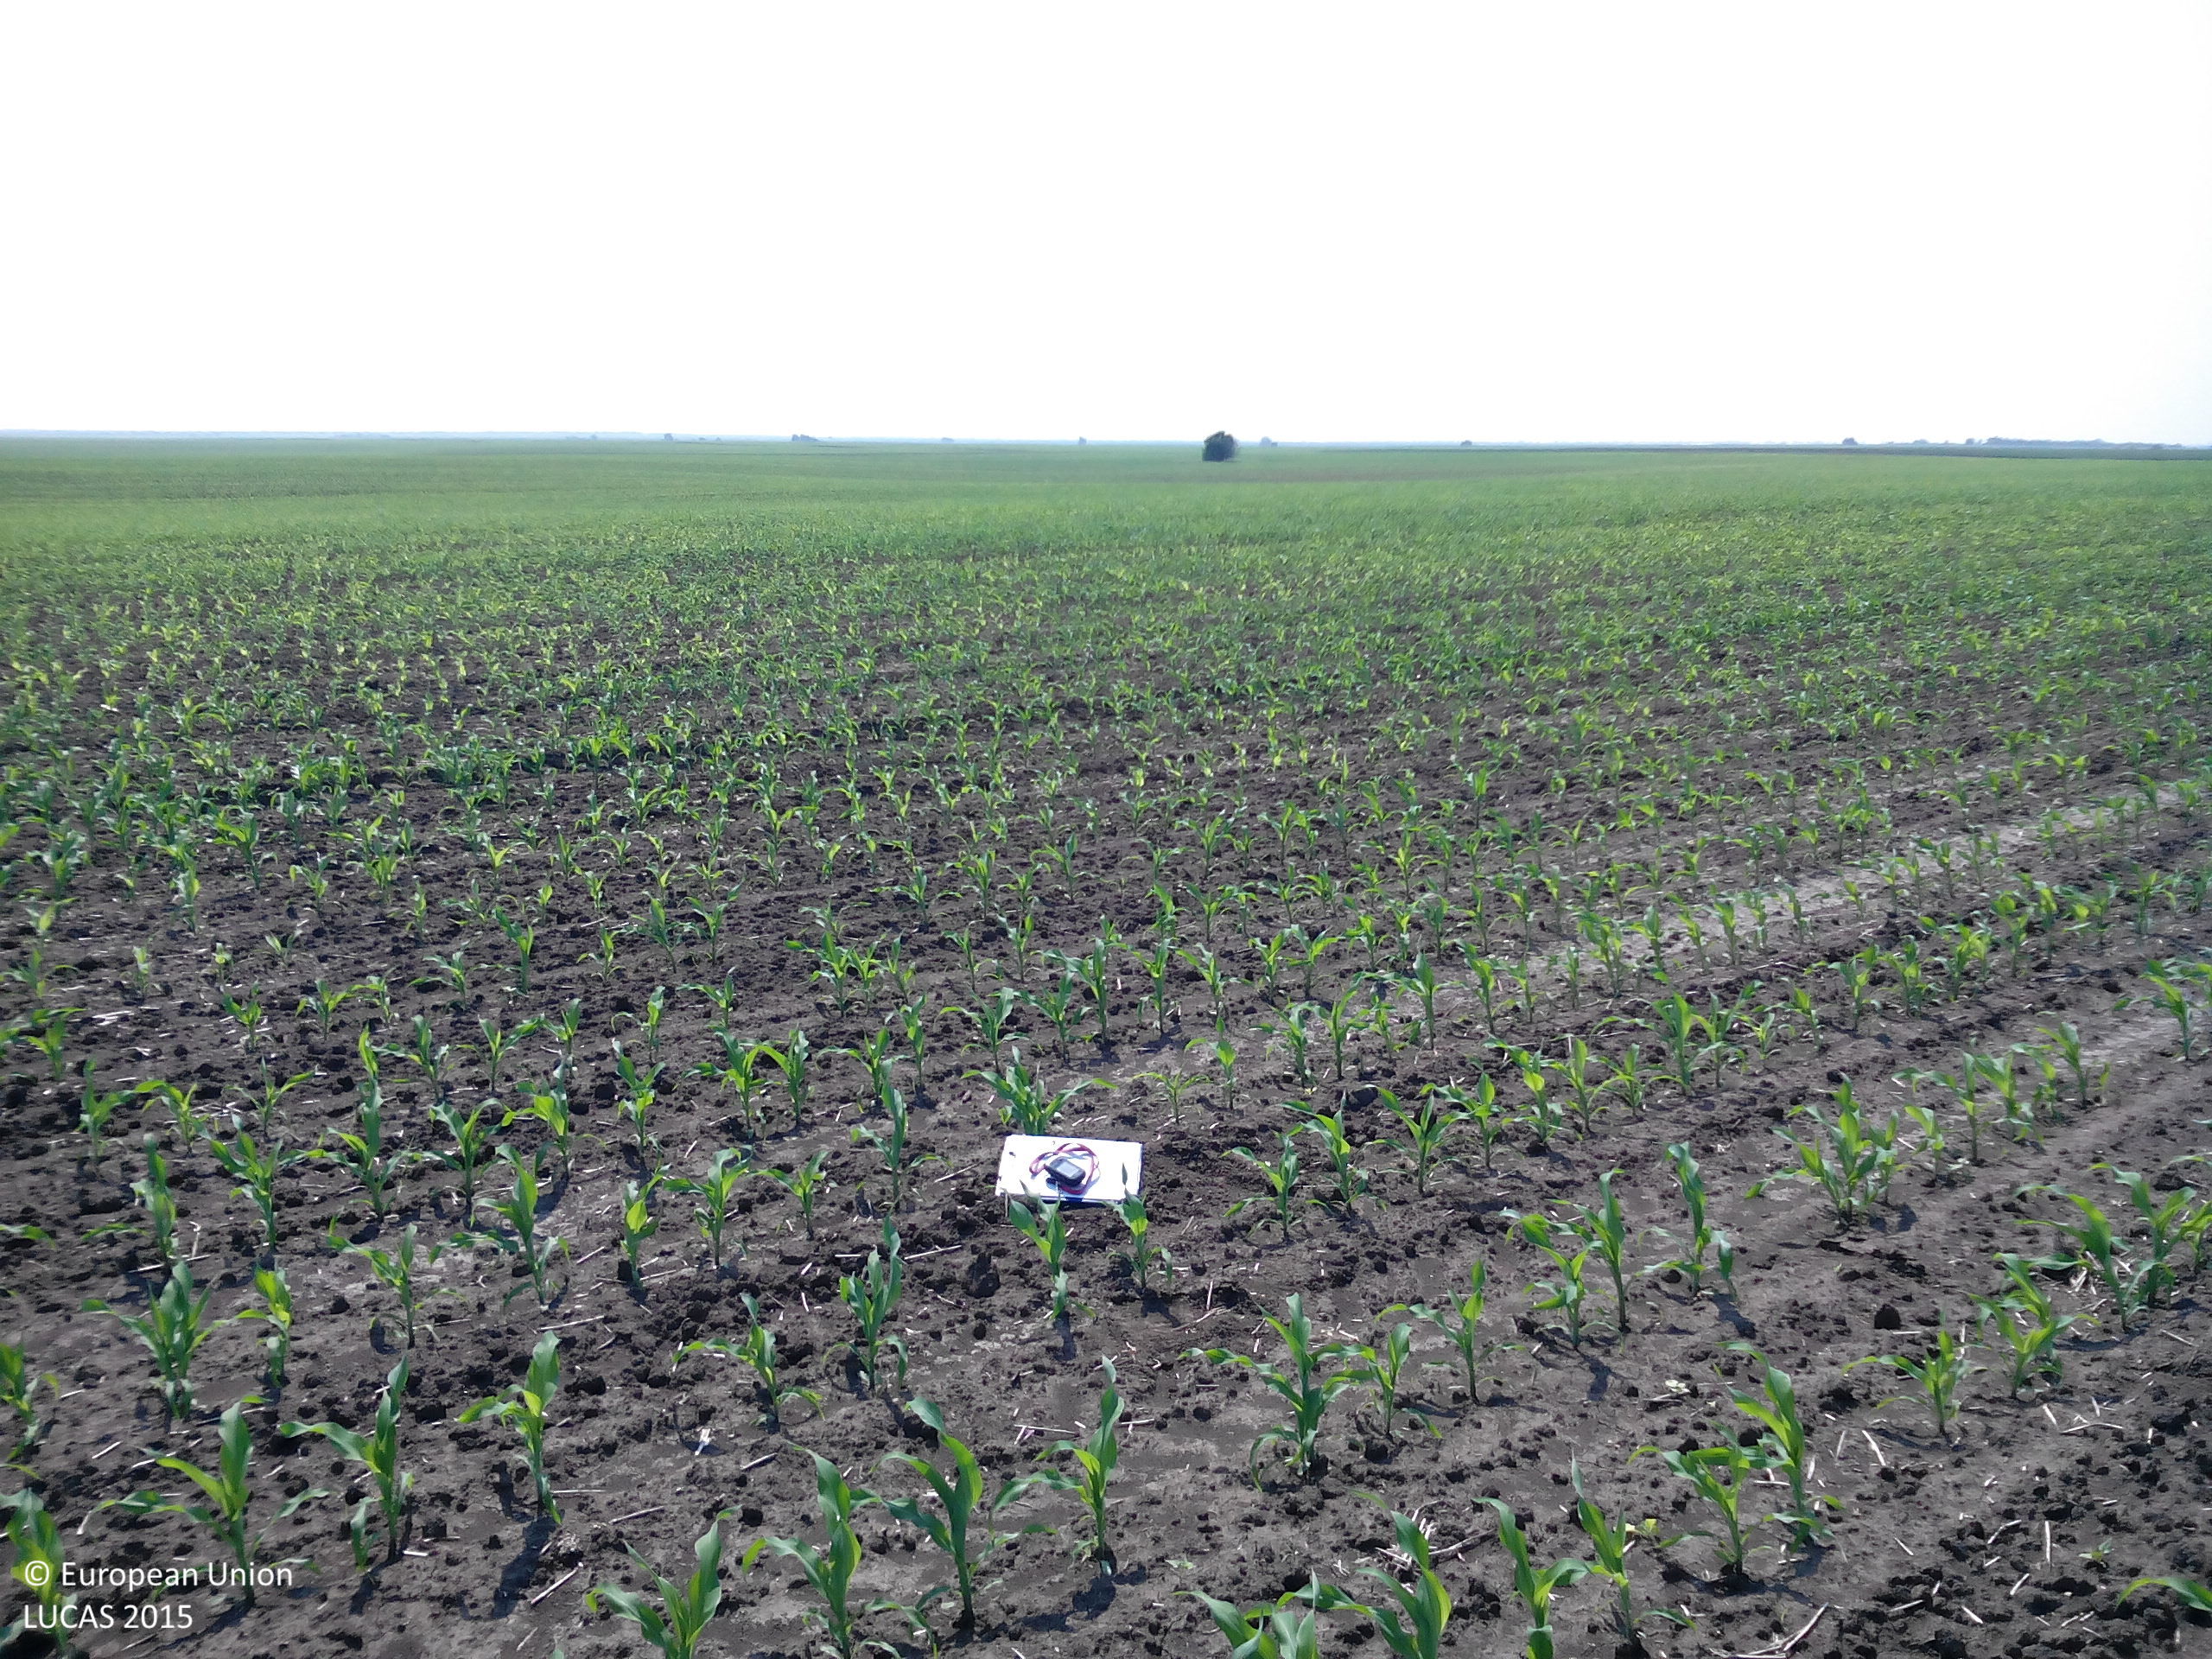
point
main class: Cropland
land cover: Maize
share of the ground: 10 - 25 %
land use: Agriculture (excluding fallow land and kitchen gardens)
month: May
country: BG
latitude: 43.6348
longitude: 24.1246
